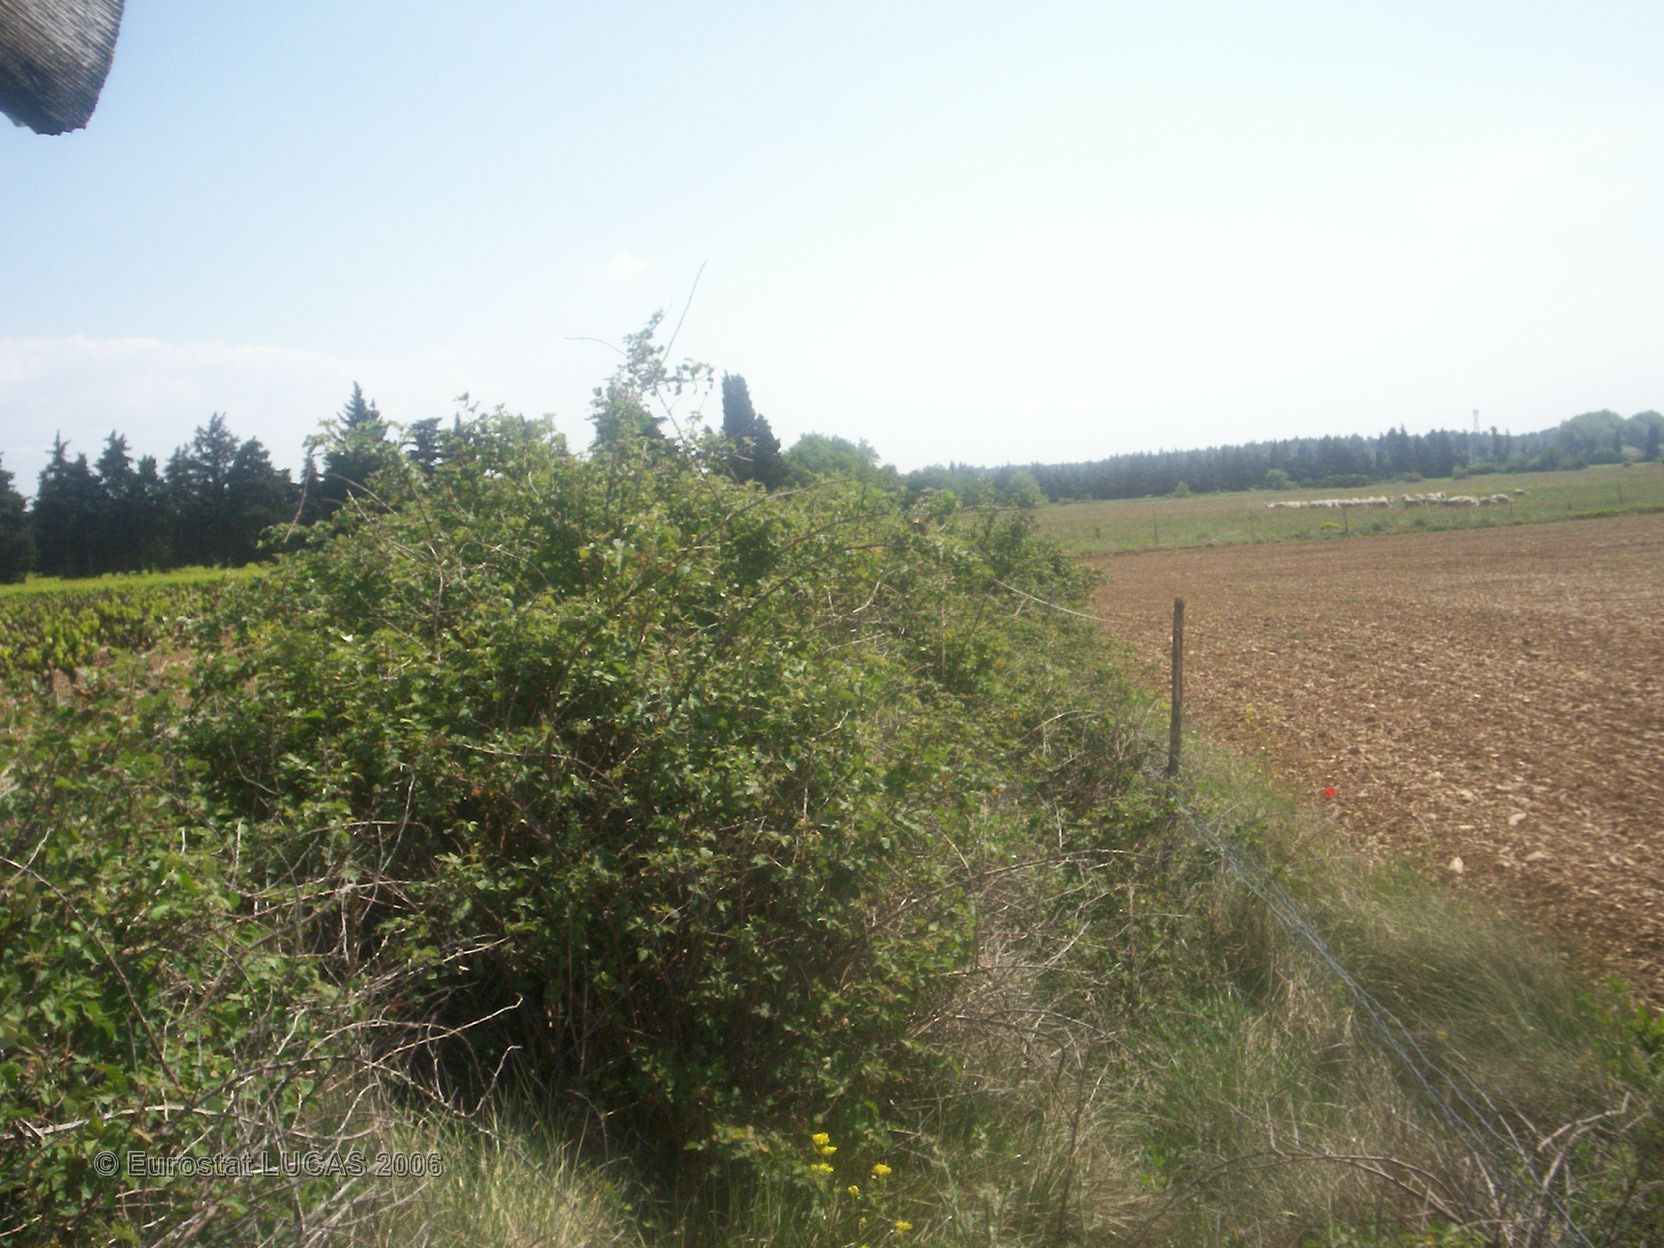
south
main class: Grassland
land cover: Grassland without tree/shrub cover
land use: Agriculture (excluding fallow land and kitchen gardens)
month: June
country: FR
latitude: 44.1371
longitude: 4.9456
